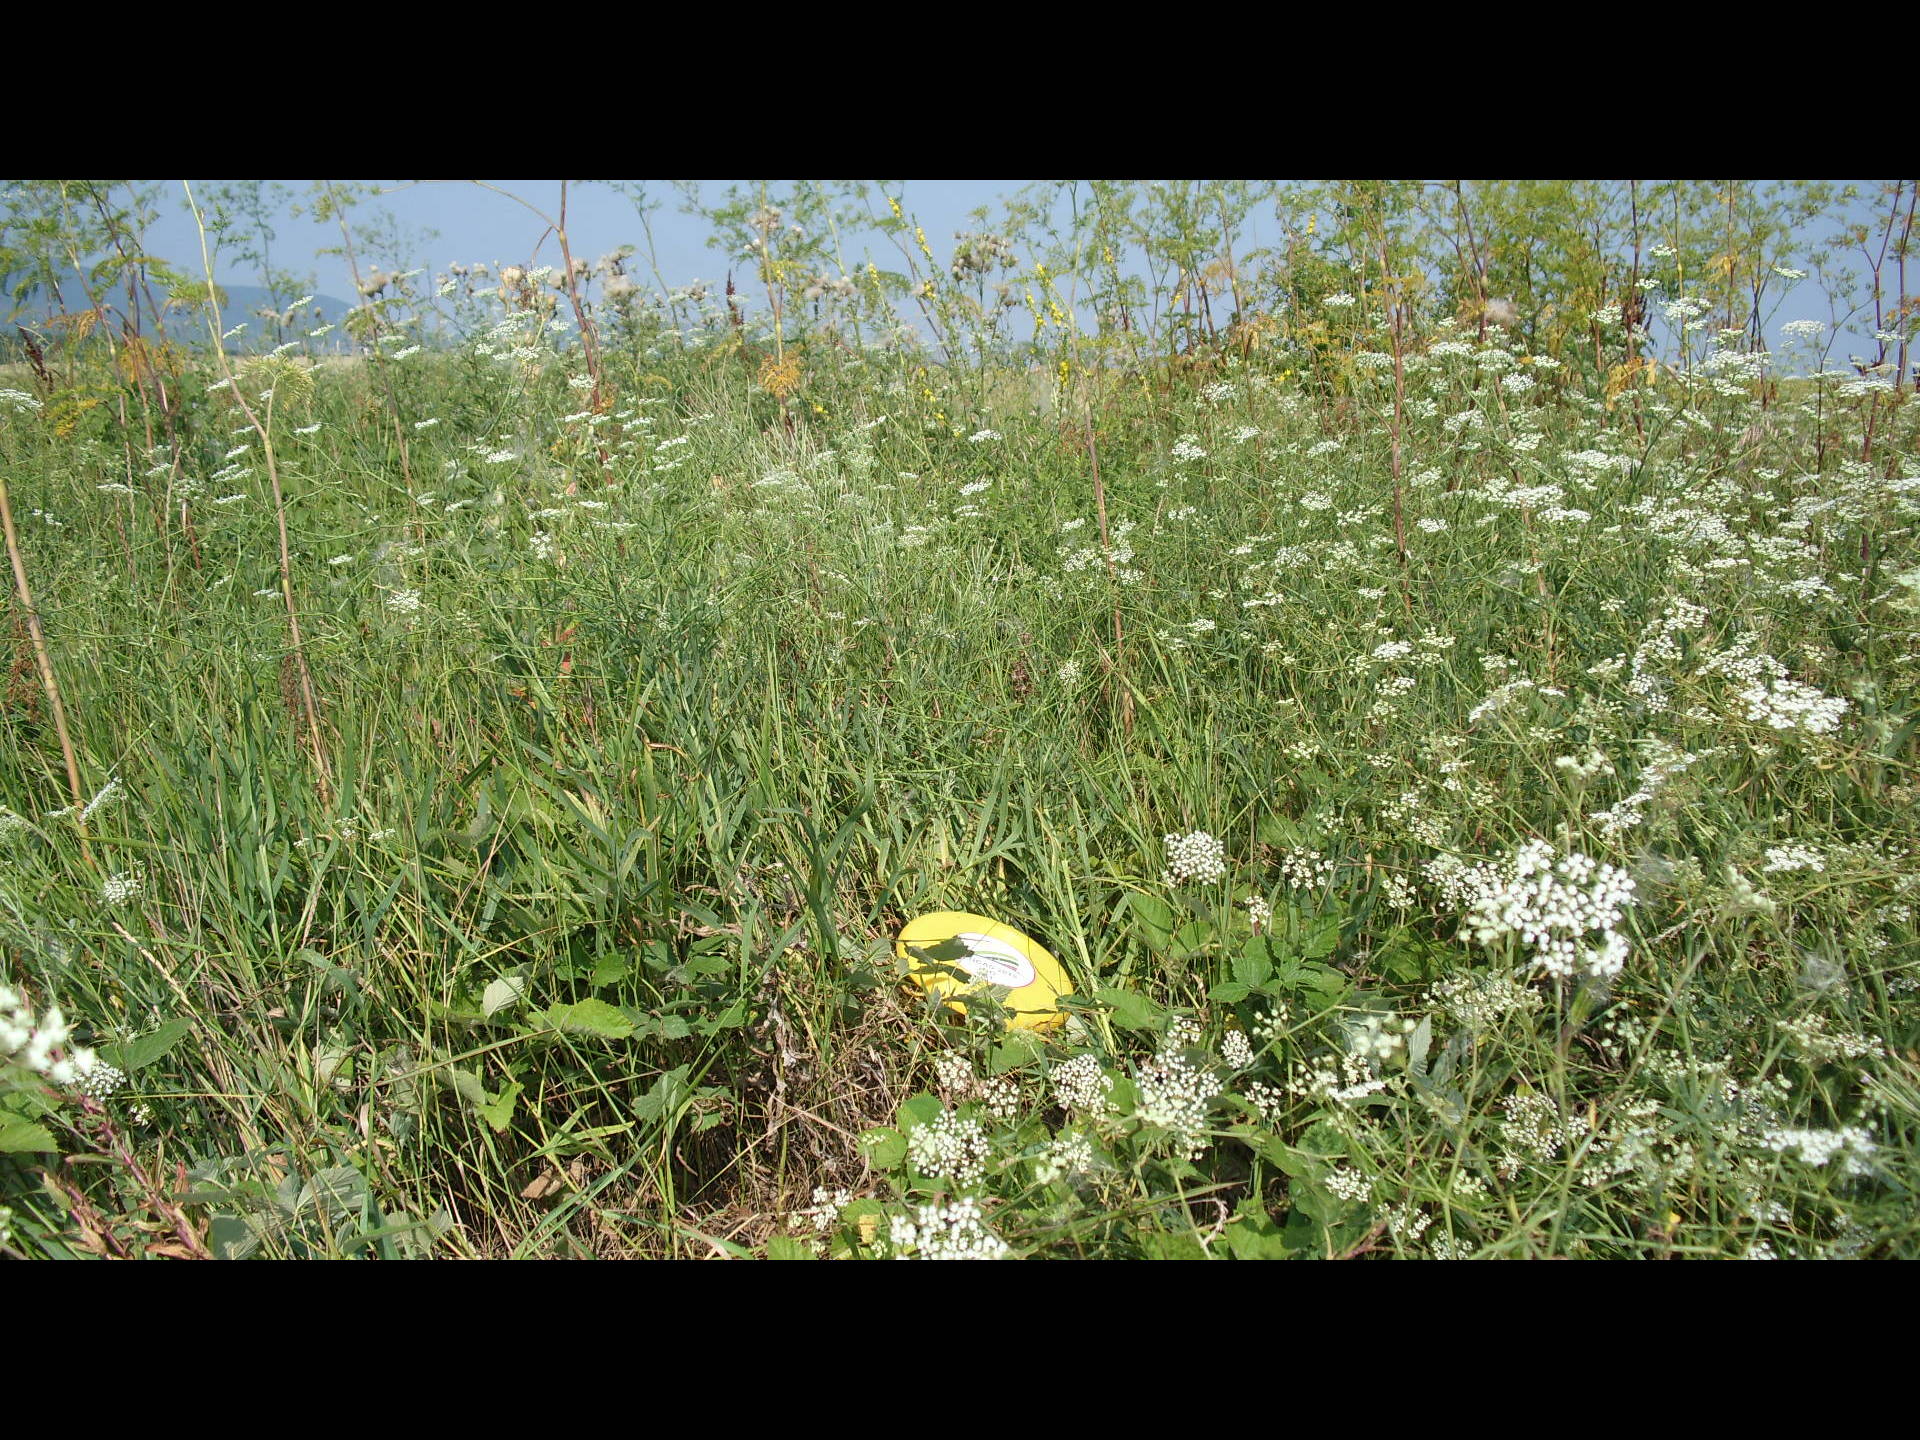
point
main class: Grassland
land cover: Grassland with sparse tree/shrub cover
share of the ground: > 75 %
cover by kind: herbaceous plants 85 %, shrubs 10 %, broadleaved forest trees 5 %
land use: Agriculture (excluding fallow land and kitchen gardens)
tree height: < 5 m
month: July
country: BG
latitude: 43.6433
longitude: 22.8170
